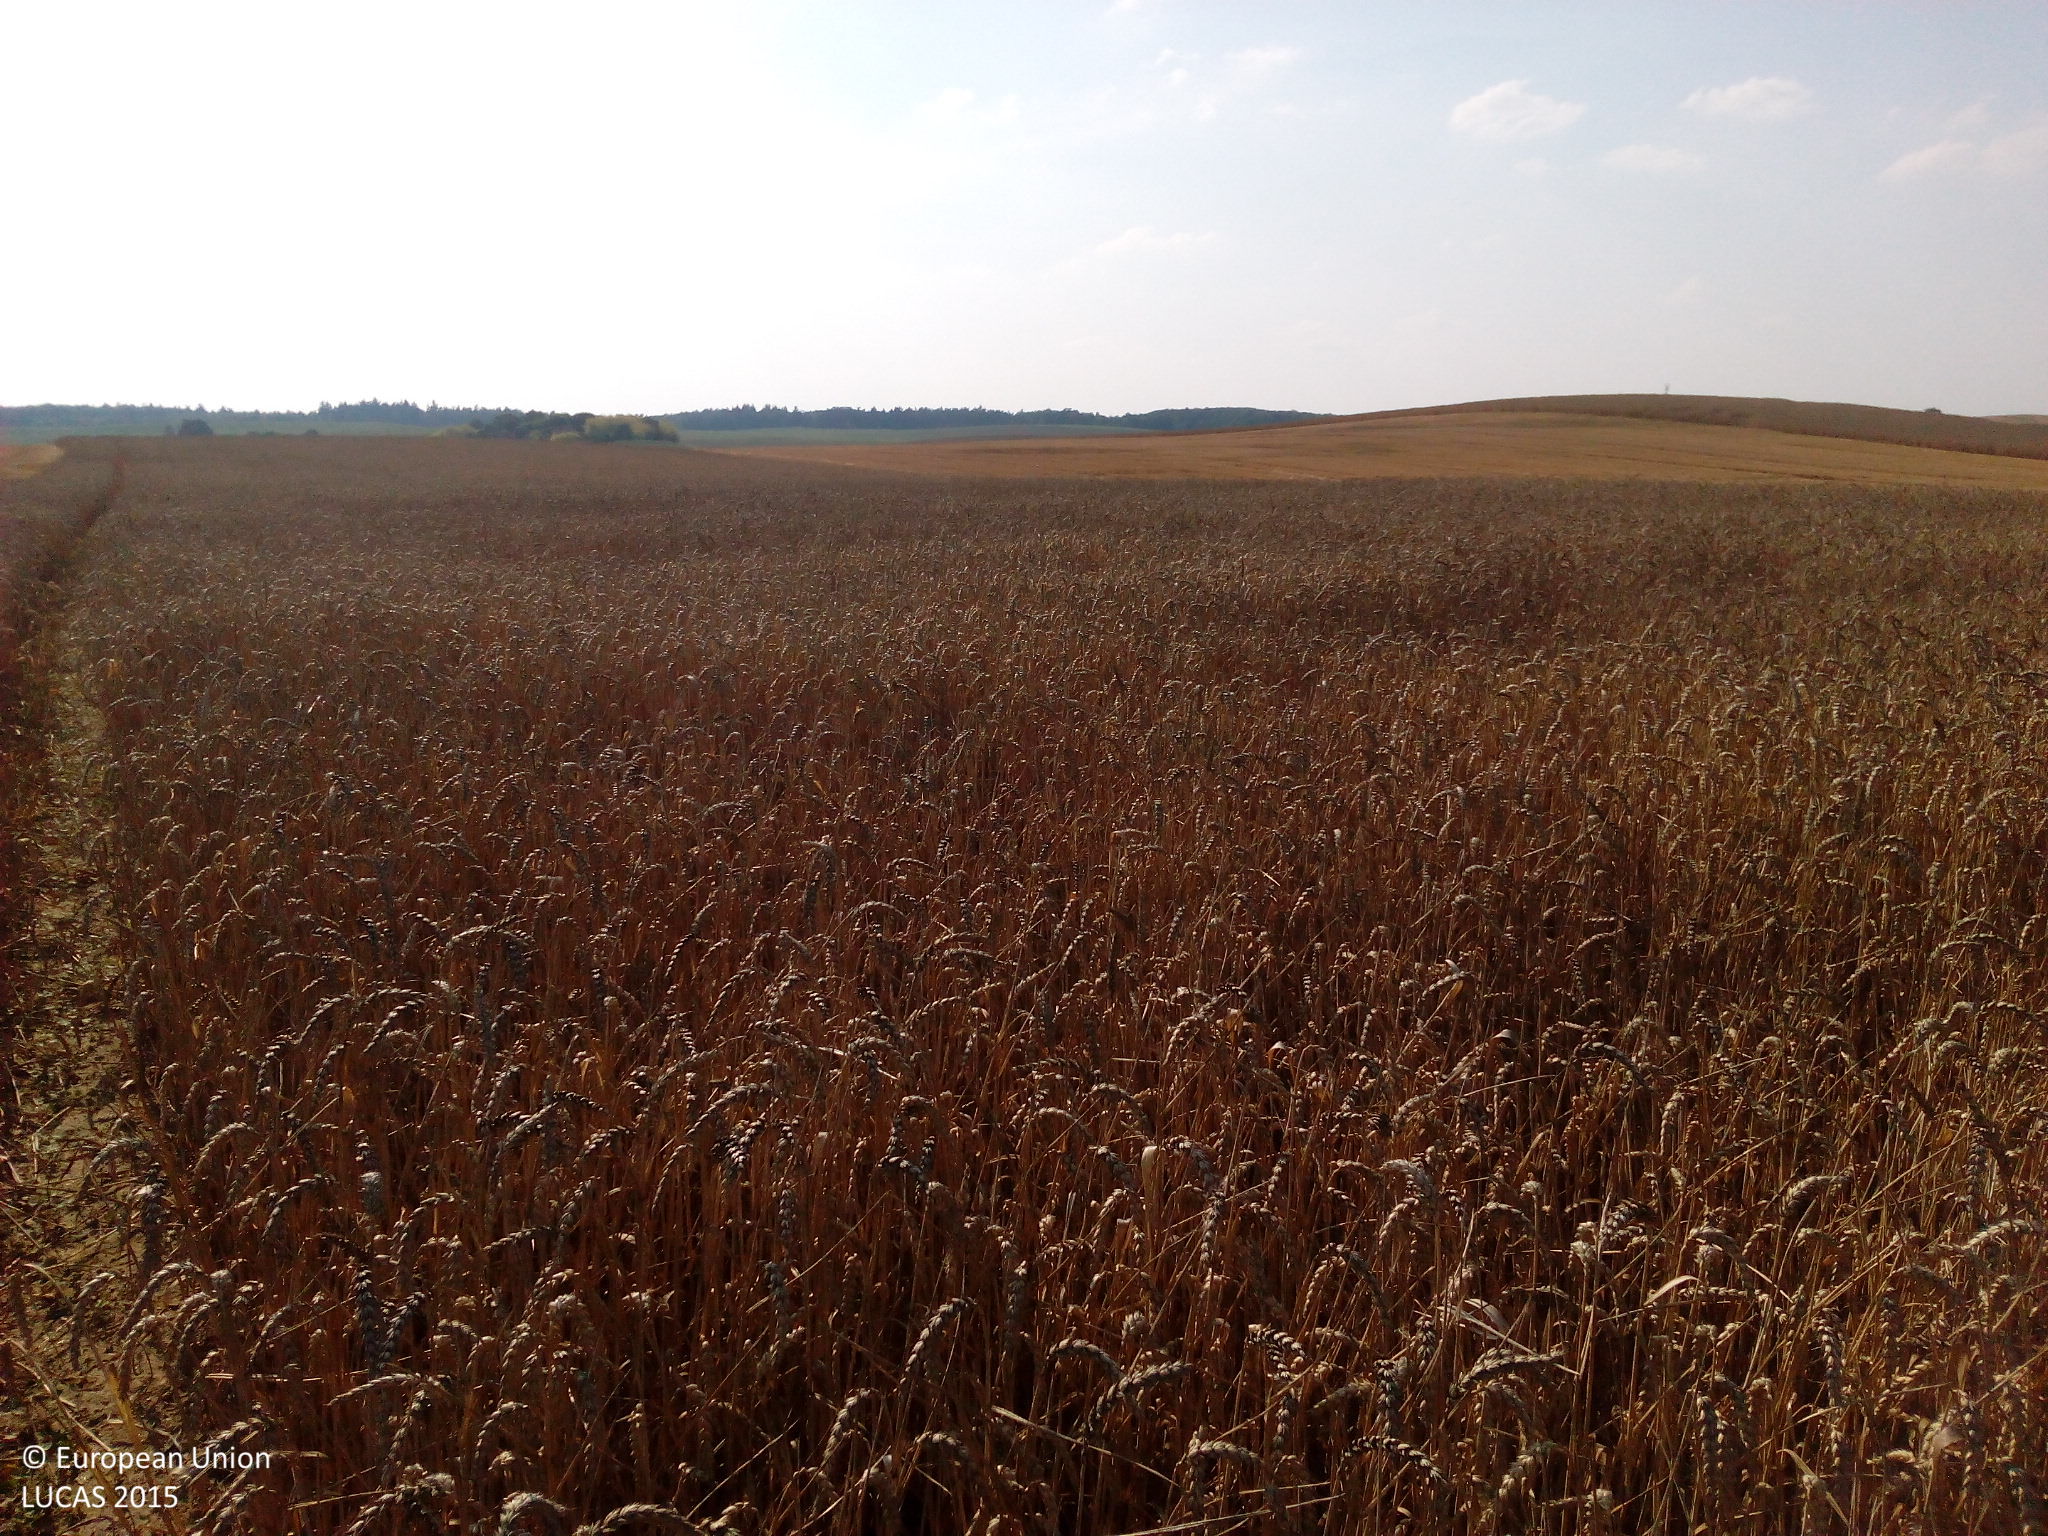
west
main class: Cropland
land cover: Common wheat
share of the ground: > 75 %
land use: Agriculture (excluding fallow land and kitchen gardens)
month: August
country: DE
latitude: 53.0245
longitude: 14.1604
